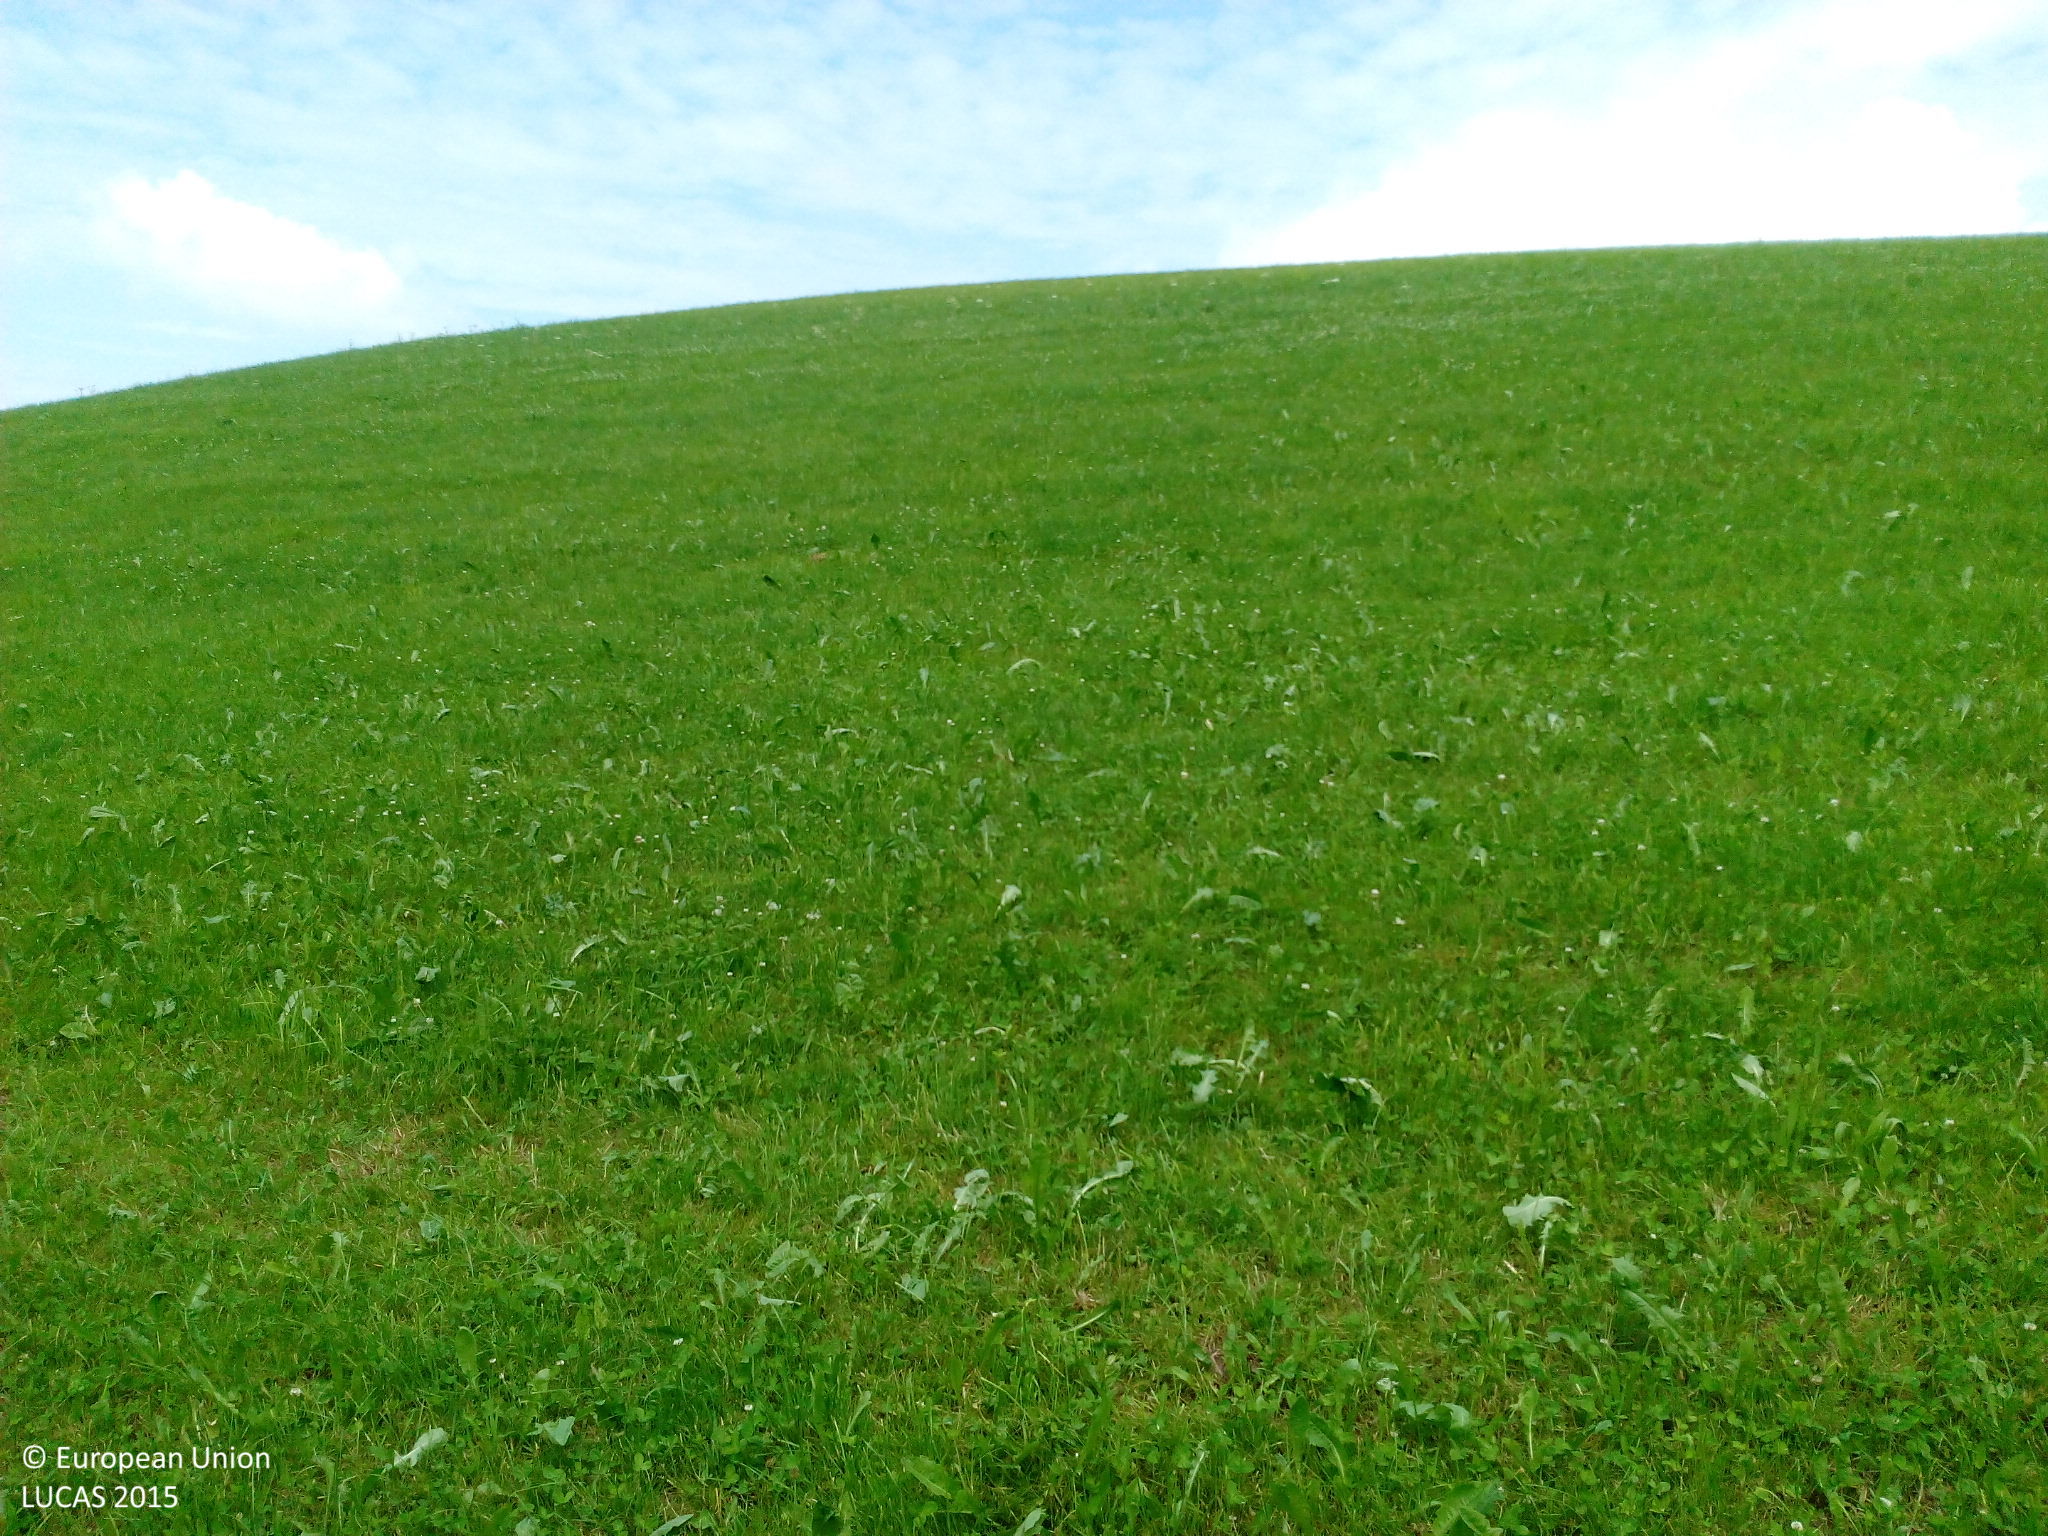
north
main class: Grassland
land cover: Grassland without tree/shrub cover
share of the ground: > 75 %
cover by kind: herbaceous plants 100 %
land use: Agriculture (excluding fallow land and kitchen gardens)
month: June
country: DE
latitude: 47.5576
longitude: 9.9336
